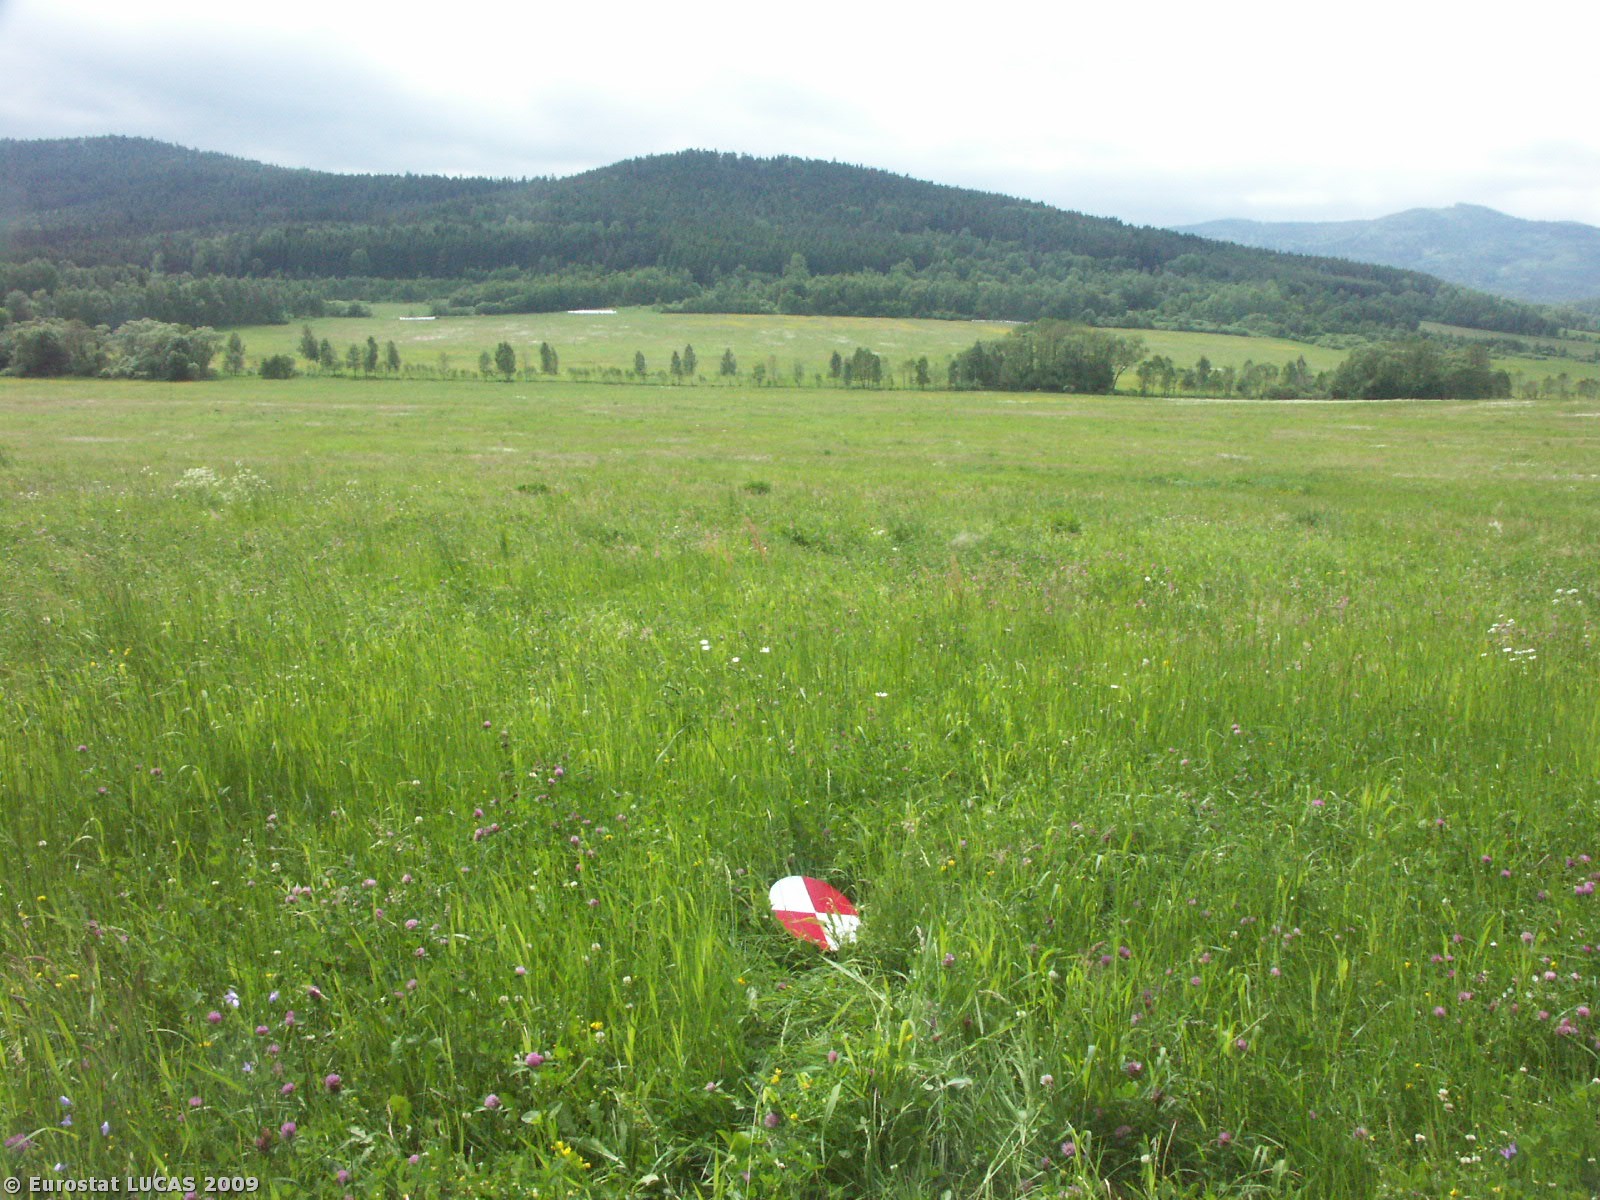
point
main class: Grassland
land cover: Grassland without tree/shrub cover
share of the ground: > 75 %
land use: Agriculture (excluding fallow land and kitchen gardens)
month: May
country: CZ
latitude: 48.8648
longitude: 14.1856
